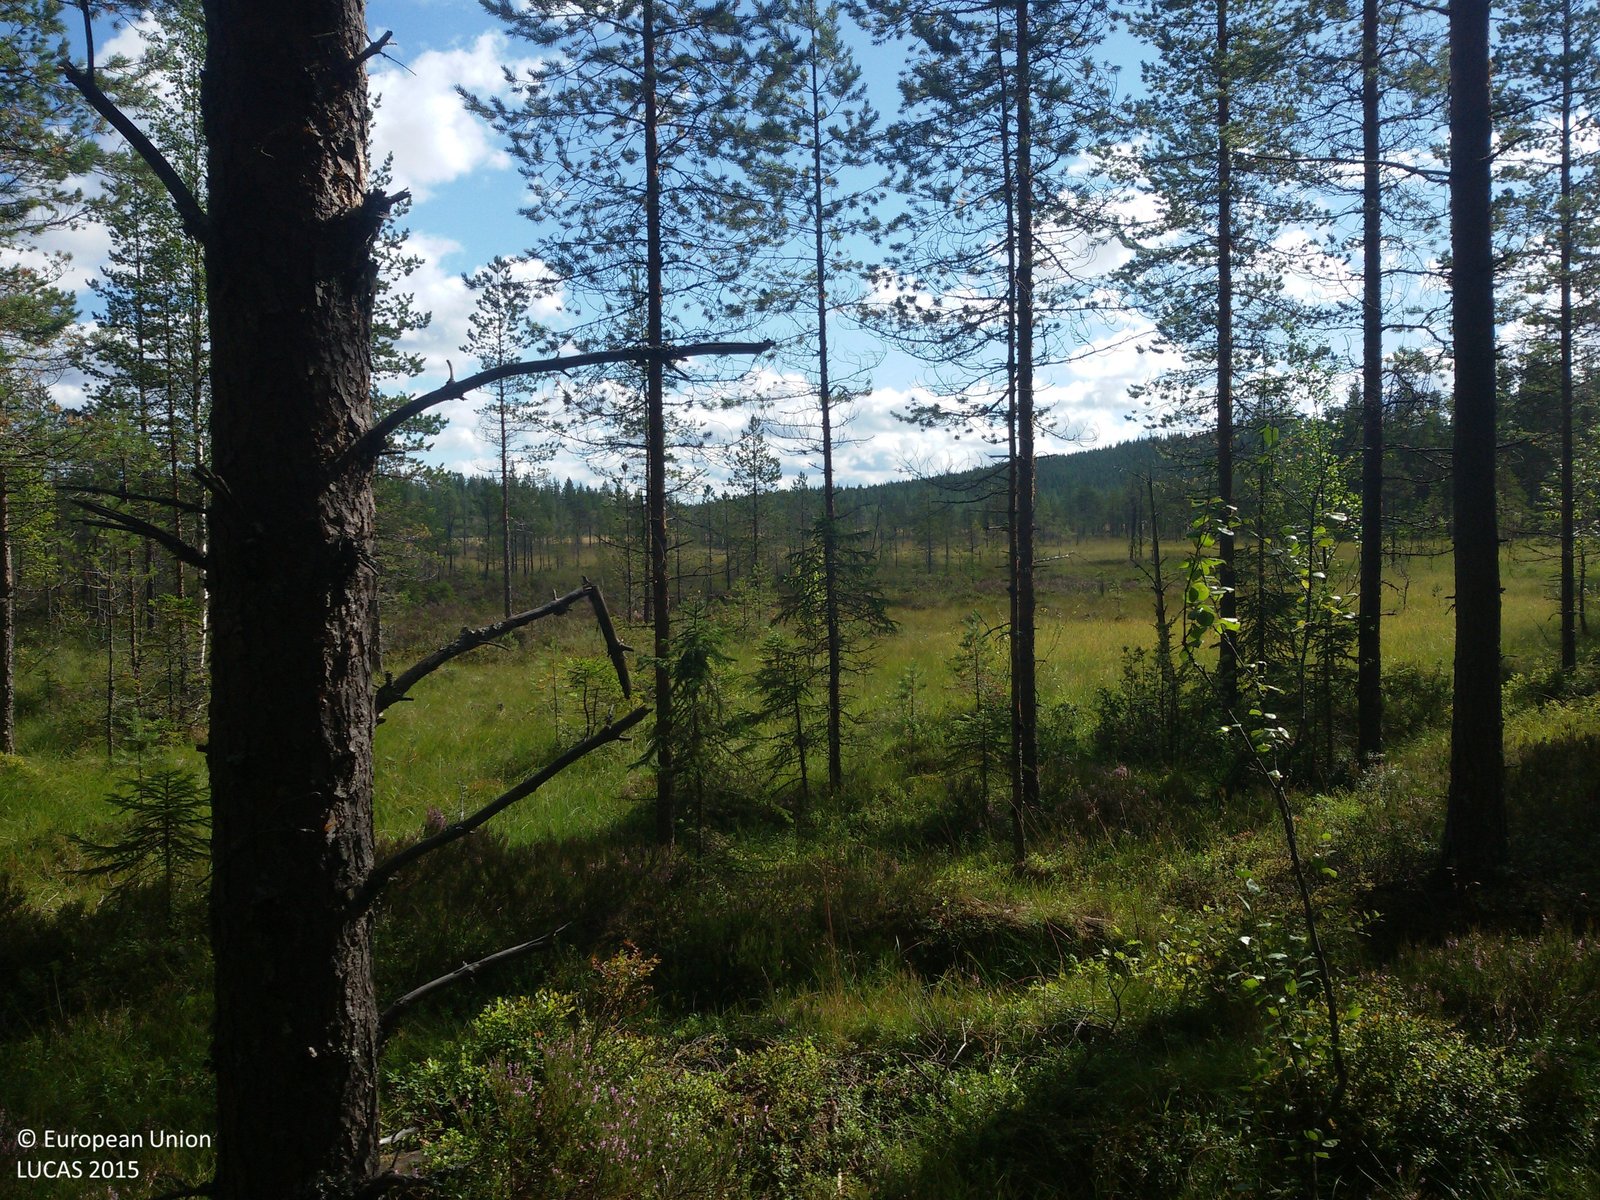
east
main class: Woodland
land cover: Pine dominated coniferous woodland
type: boreal forest
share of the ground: 50 - 75 %
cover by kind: coniferous forest trees 70 %, herbaceous plants 25 %, lichens and mosses 5 %
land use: Forestry
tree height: > 5 m
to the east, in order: Pine dominated coniferous woodland
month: August
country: SE
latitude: 60.9762
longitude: 15.9541
